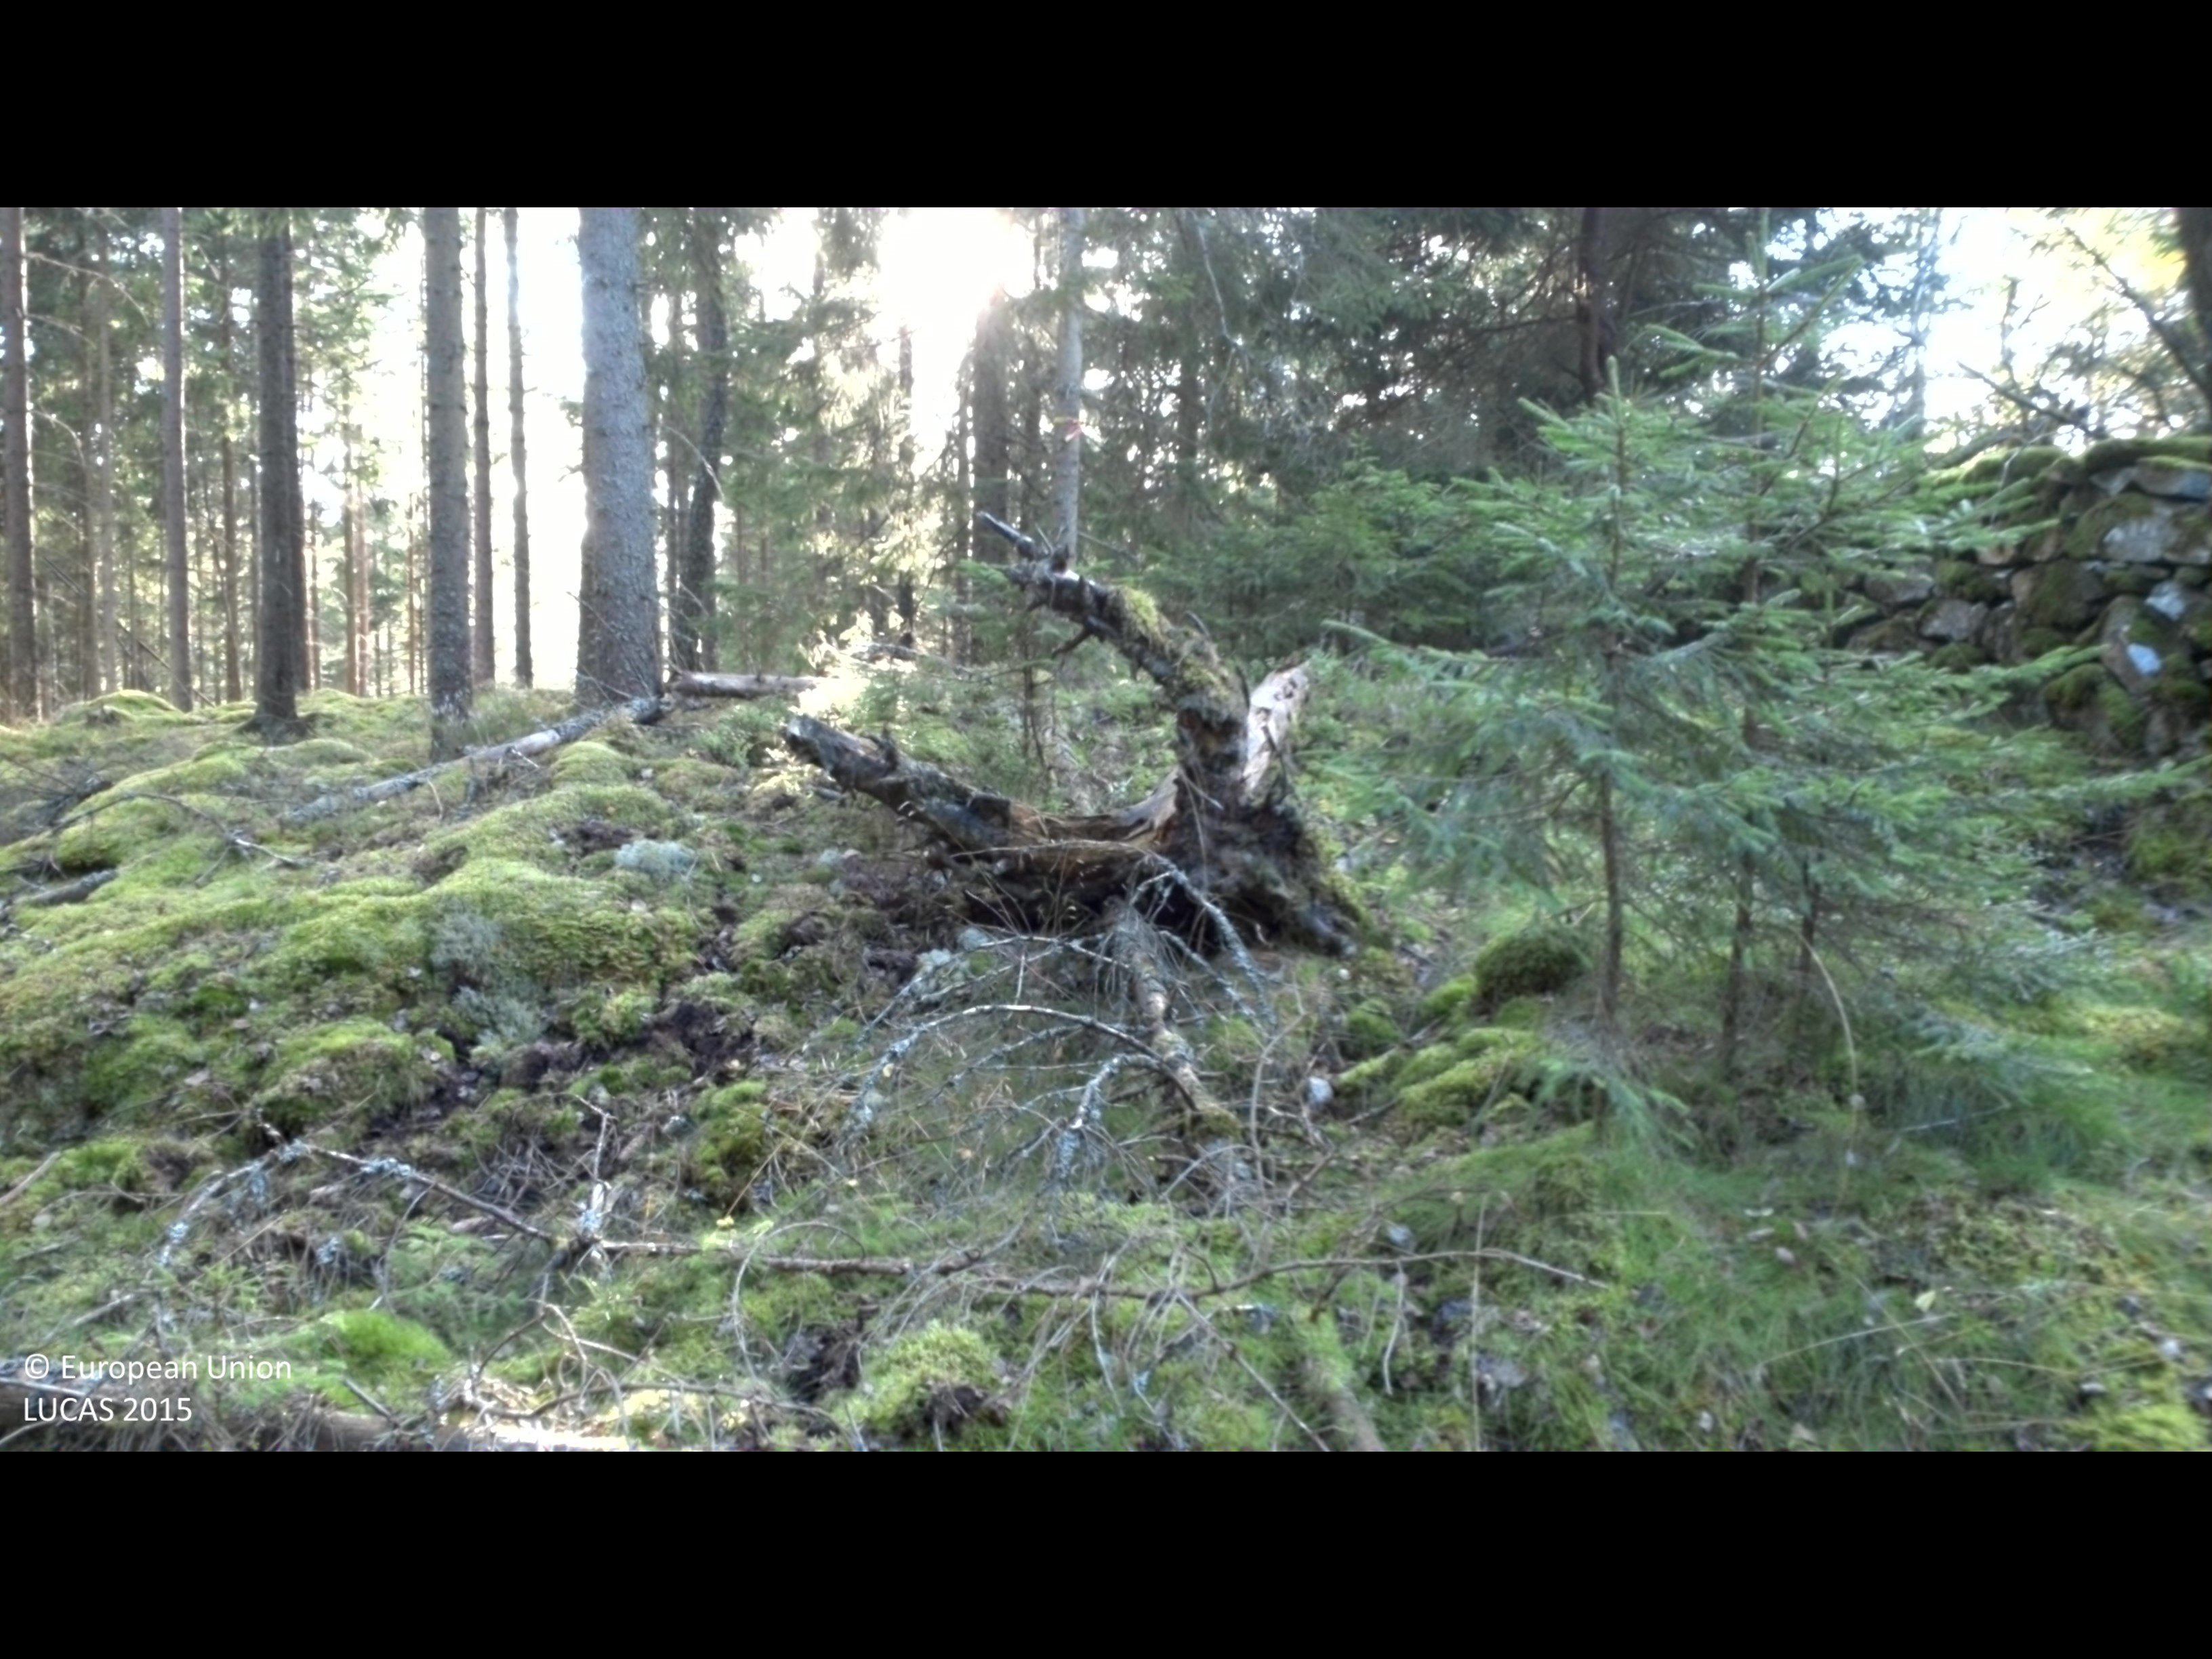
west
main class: Woodland
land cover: Spruce dominated coniferous woodland
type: boreal forest
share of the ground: 50 - 75 %
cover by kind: coniferous forest trees 55 %, lichens and mosses 35 %, shrubs 10 %
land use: Forestry
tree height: > 5 m
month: August
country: SE
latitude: 56.3449
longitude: 14.4470
